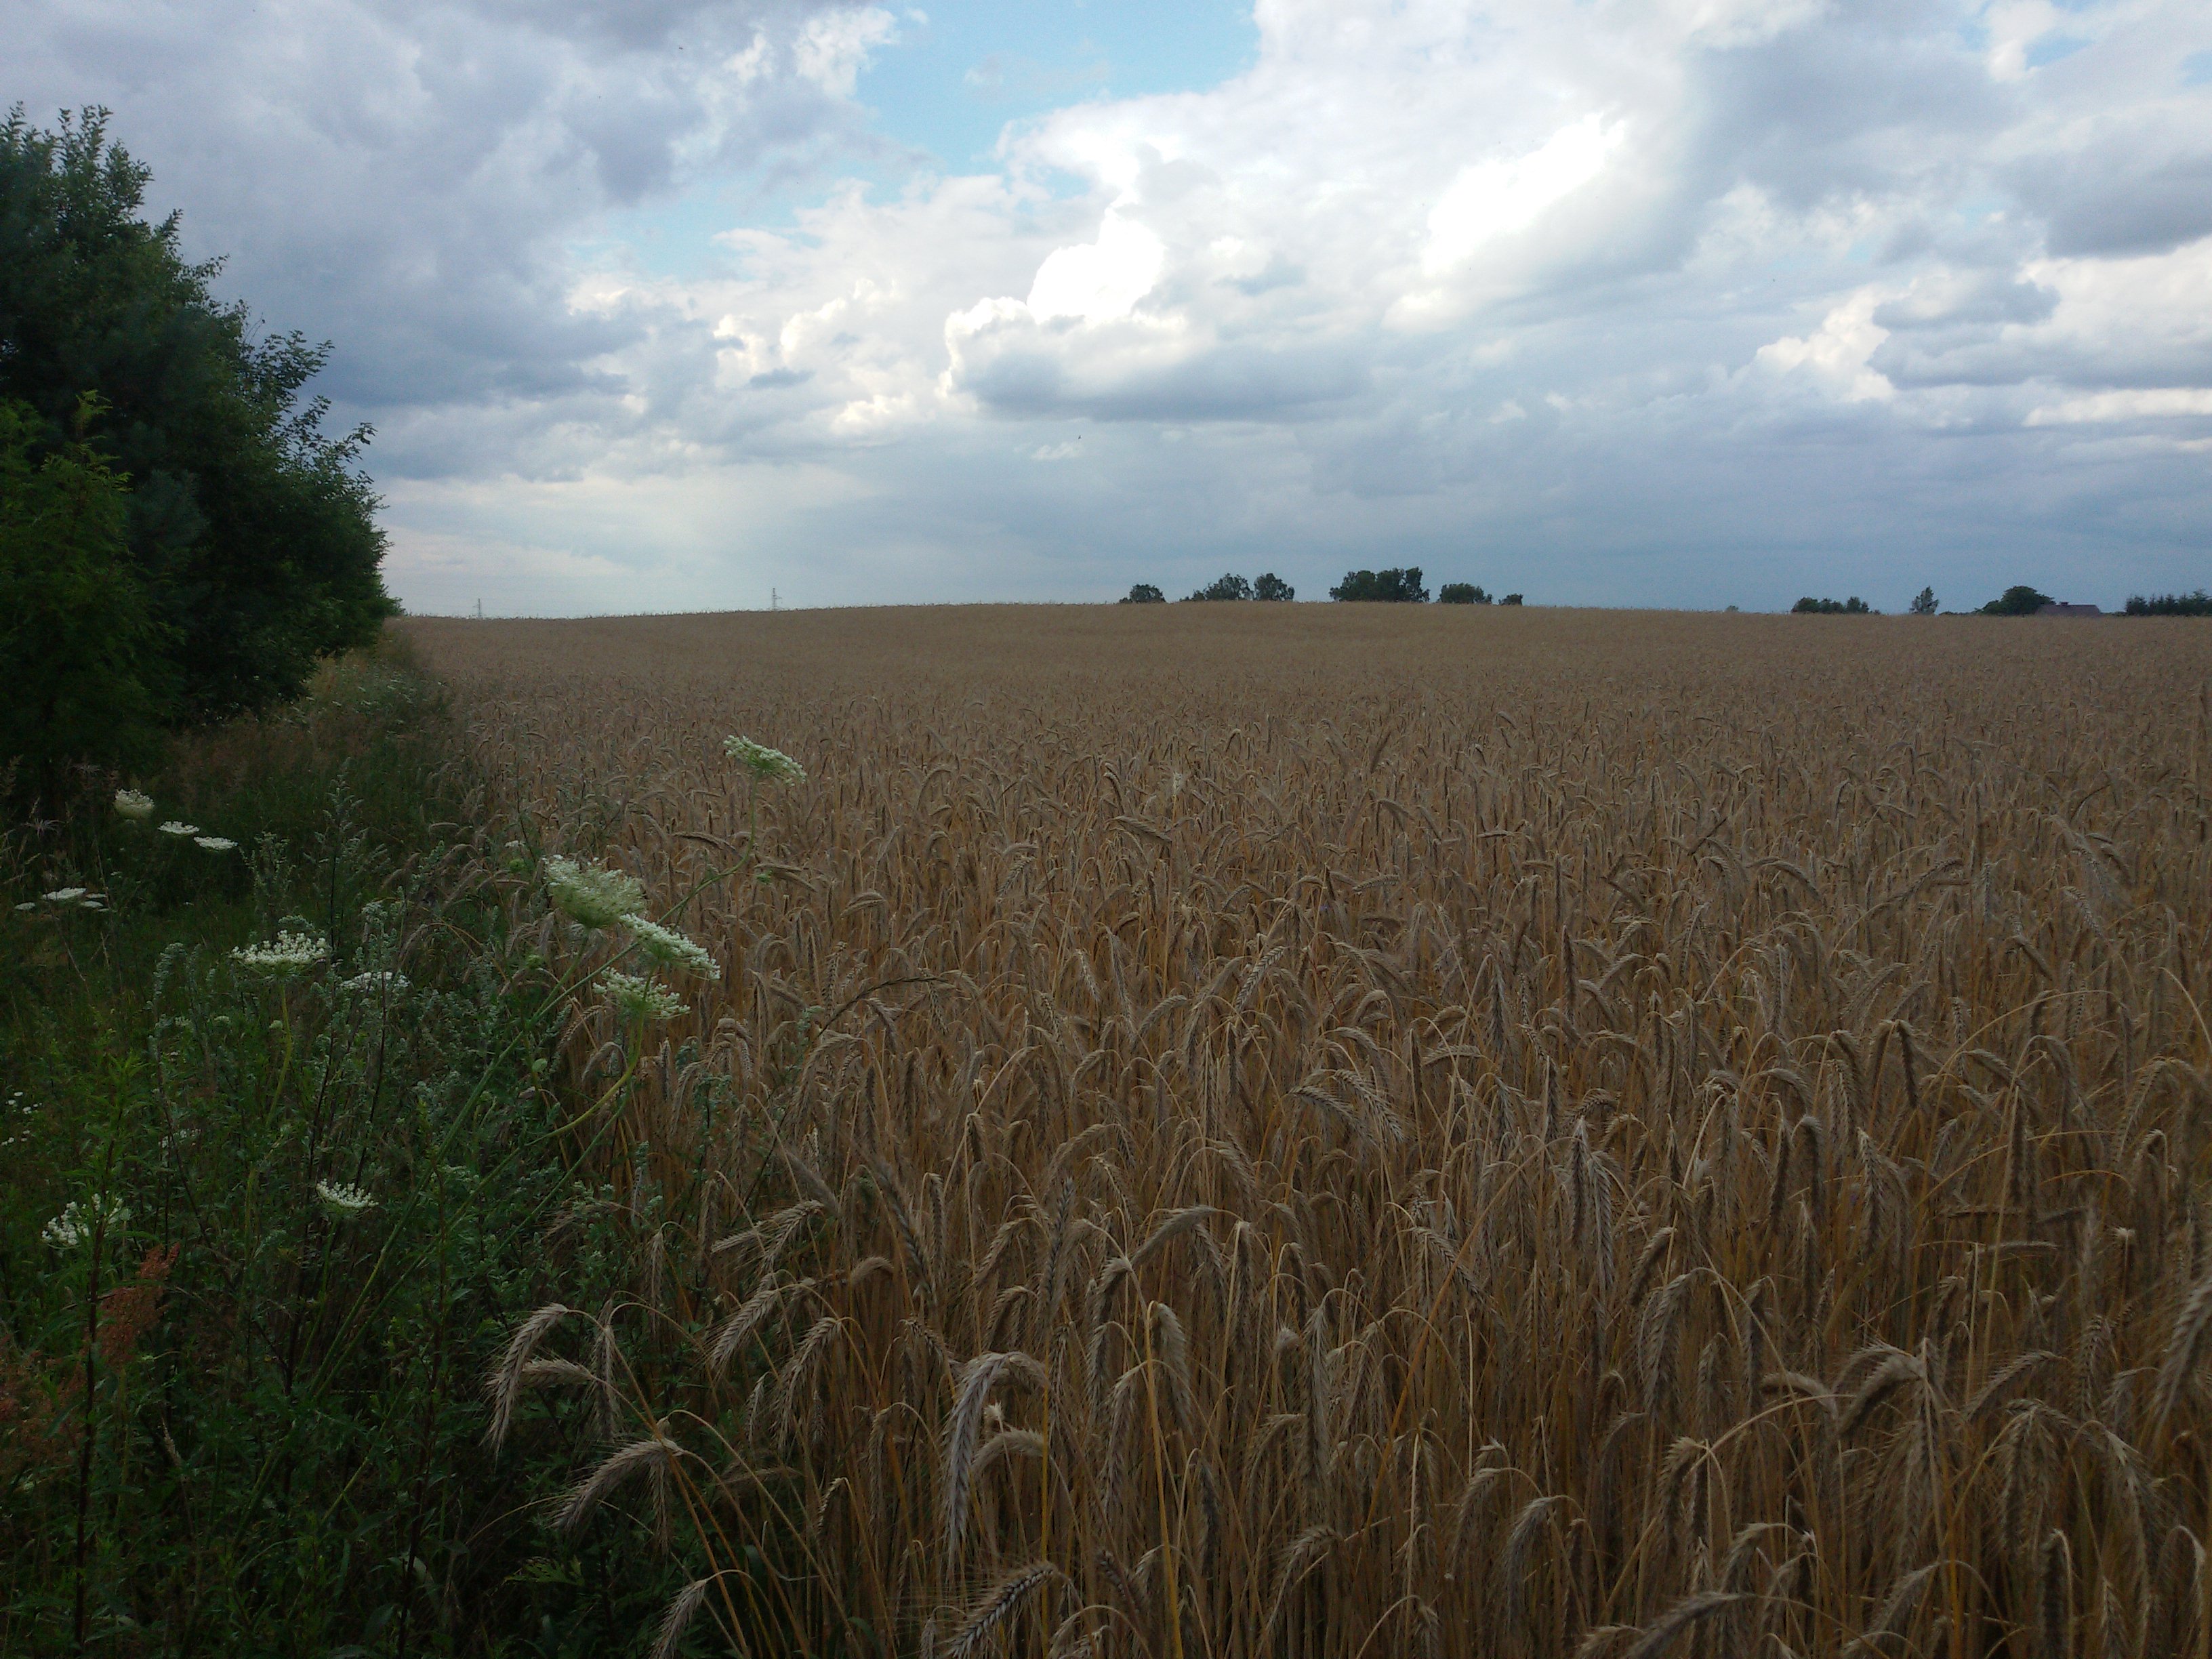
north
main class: Cropland
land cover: Rye
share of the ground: > 75 %
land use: Agriculture (excluding fallow land and kitchen gardens)
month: July
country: PL
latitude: 53.5341
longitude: 15.7827
